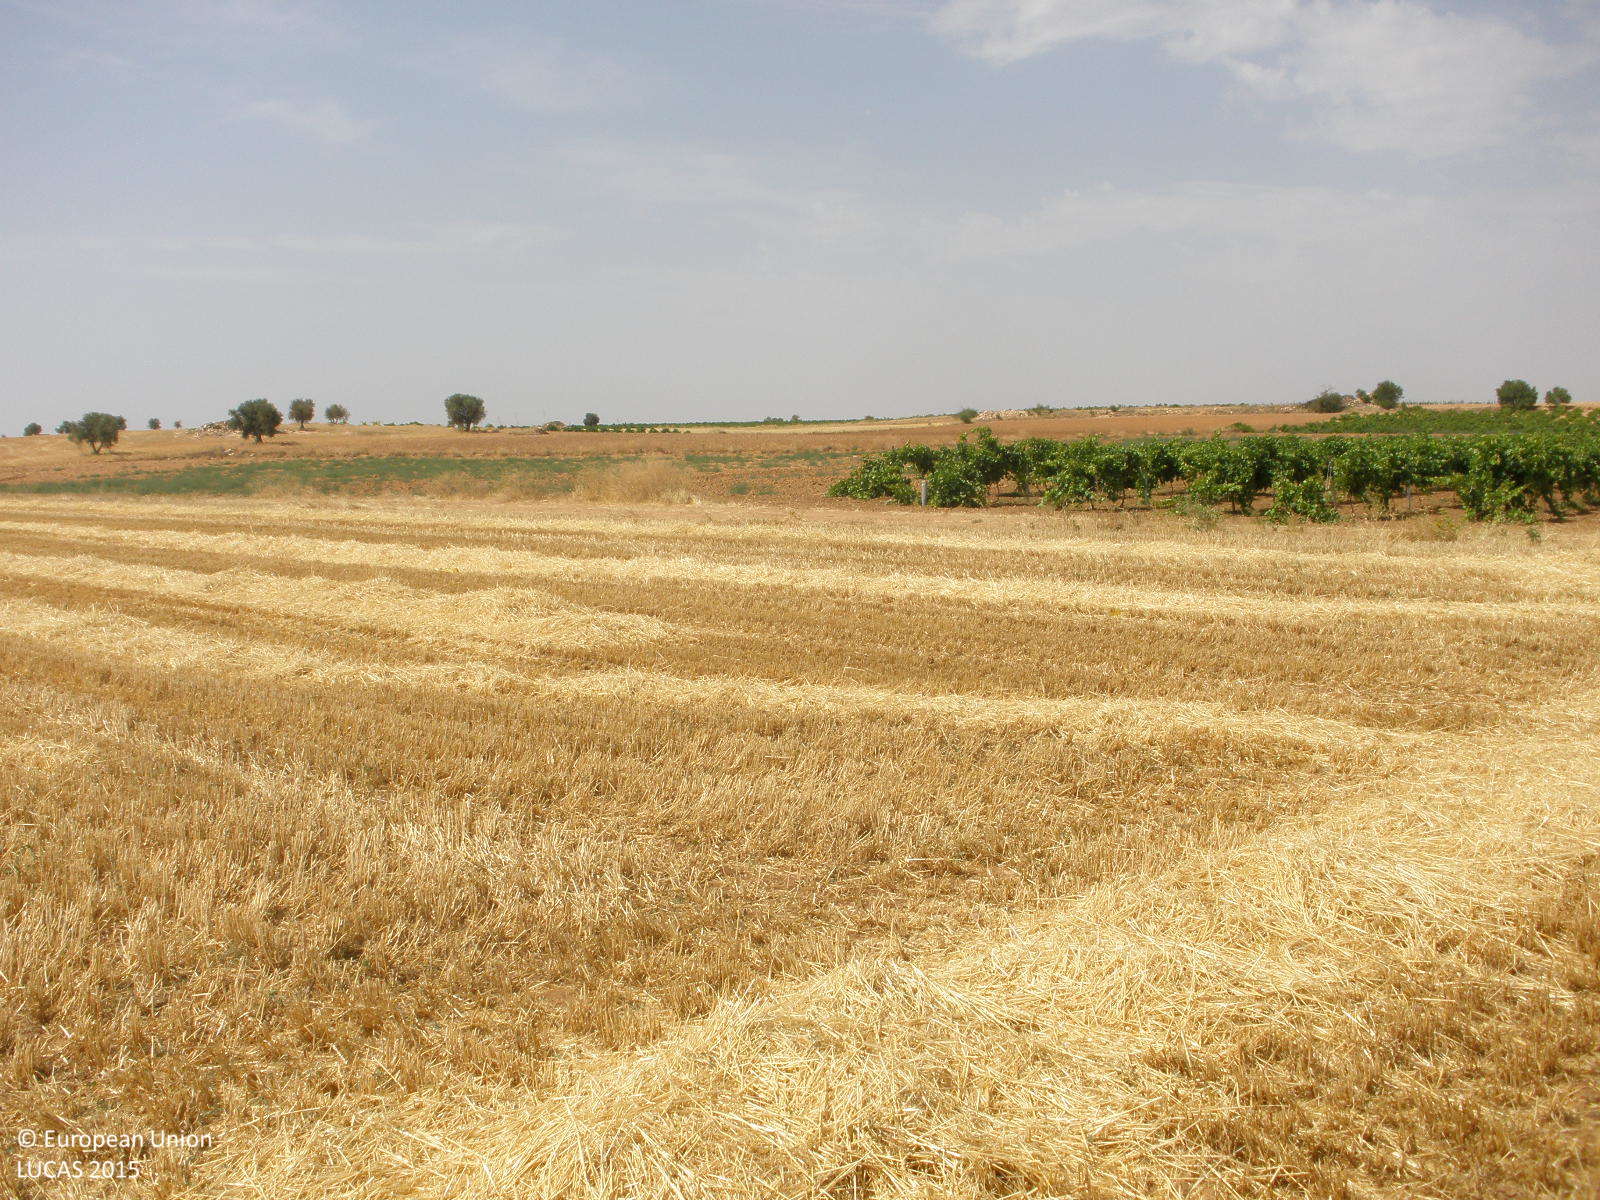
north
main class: Cropland
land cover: Barley
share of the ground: < 10 %
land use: Agriculture (excluding fallow land and kitchen gardens)
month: July
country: ES
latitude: 39.9083
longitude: -3.4211
